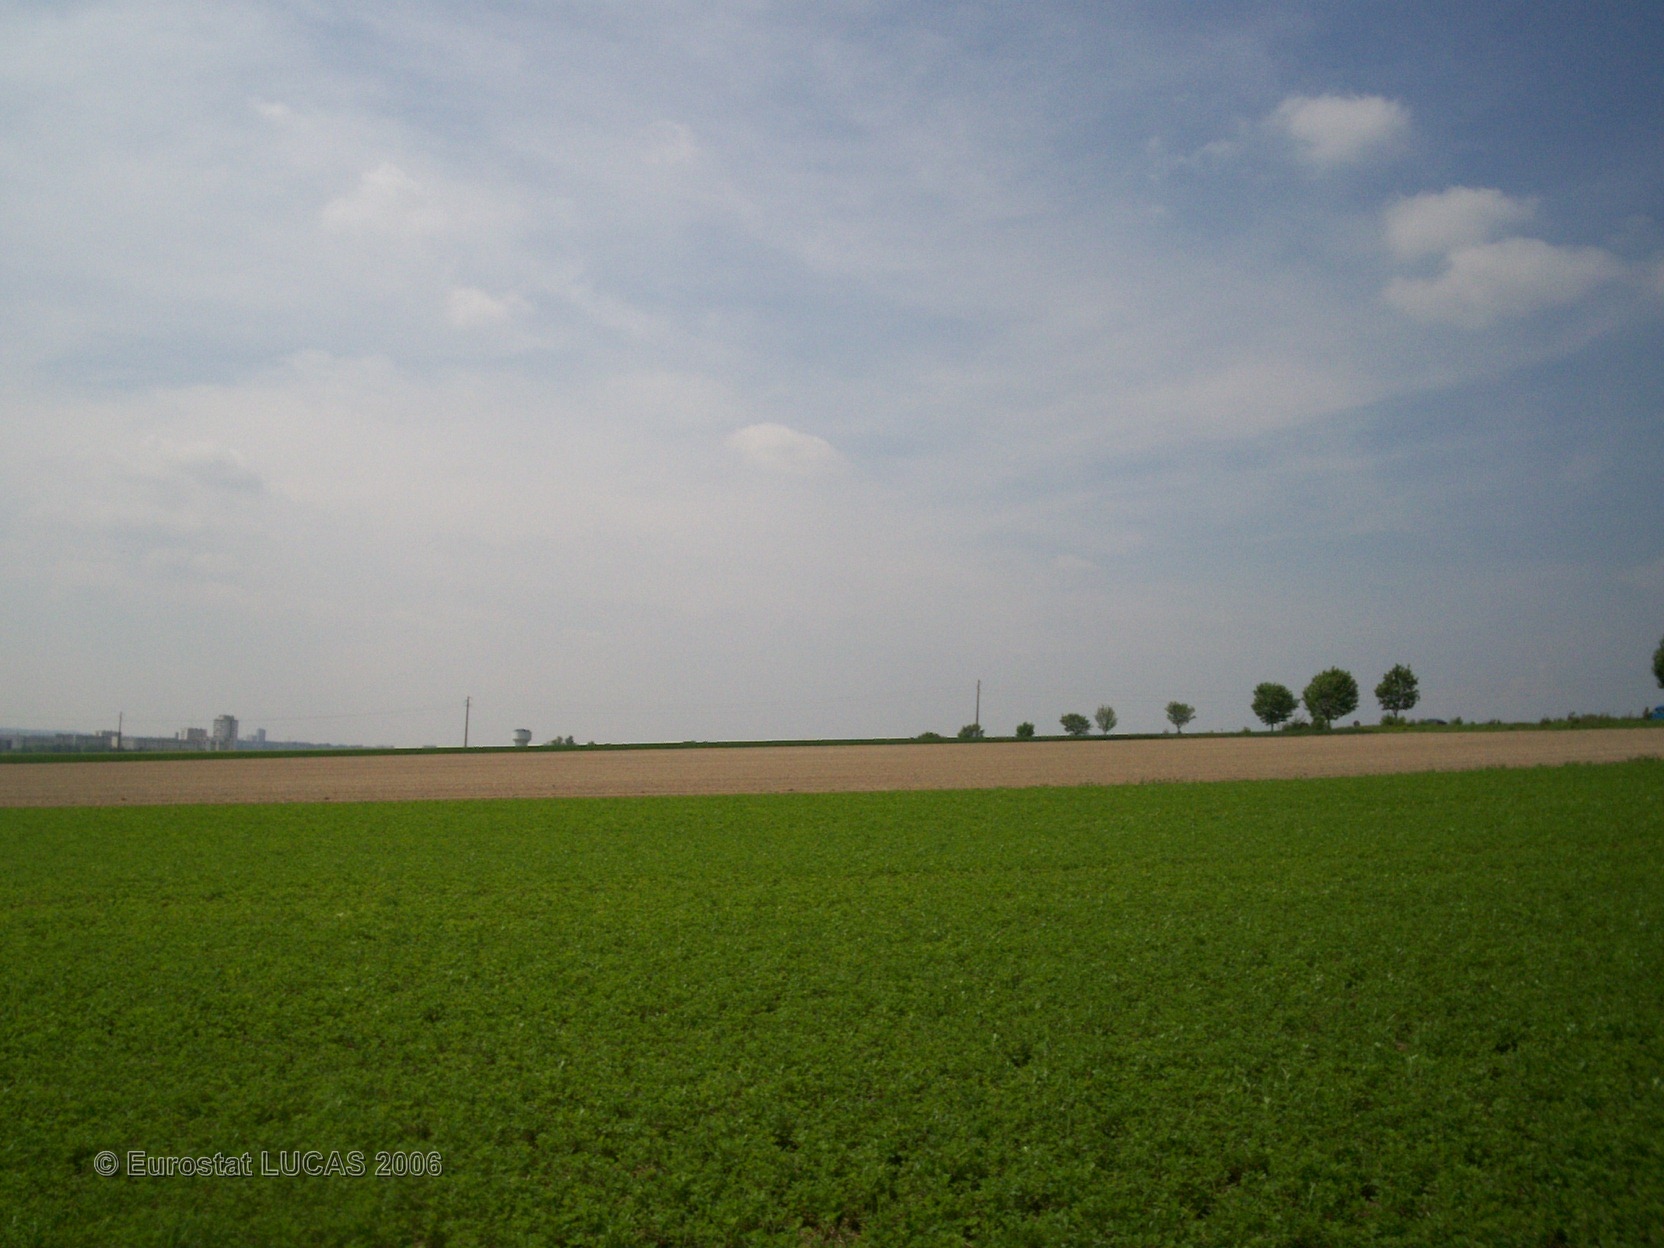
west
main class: Cropland
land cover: Lucerne
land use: Agriculture (excluding fallow land and kitchen gardens)
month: May
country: FR
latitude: 48.9654
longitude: 4.4098
